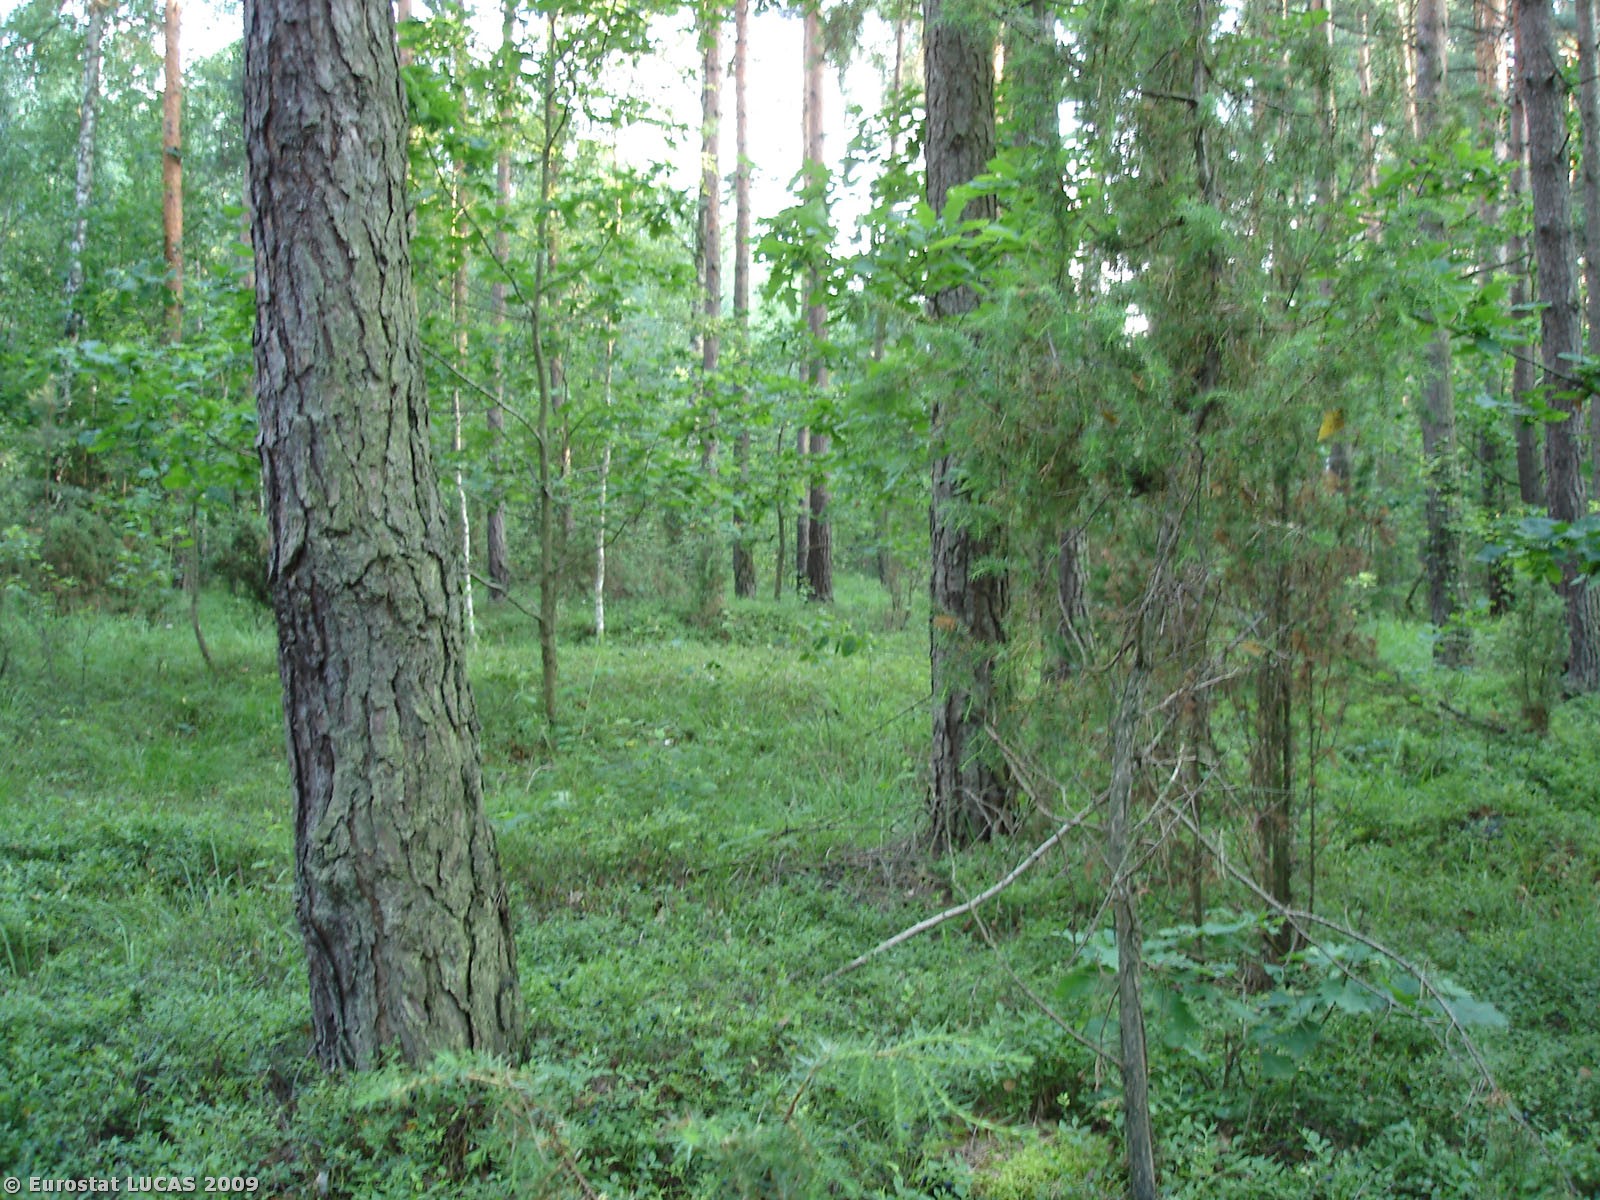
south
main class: Woodland
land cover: Mixed woodland
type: hemiboreal forest and nemoral coniferous forest and mixed broadleaved-coniferous forest
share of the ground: > 75 %
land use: Forestry
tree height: > 5 m
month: March
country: PL
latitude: 50.9307
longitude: 19.8920
